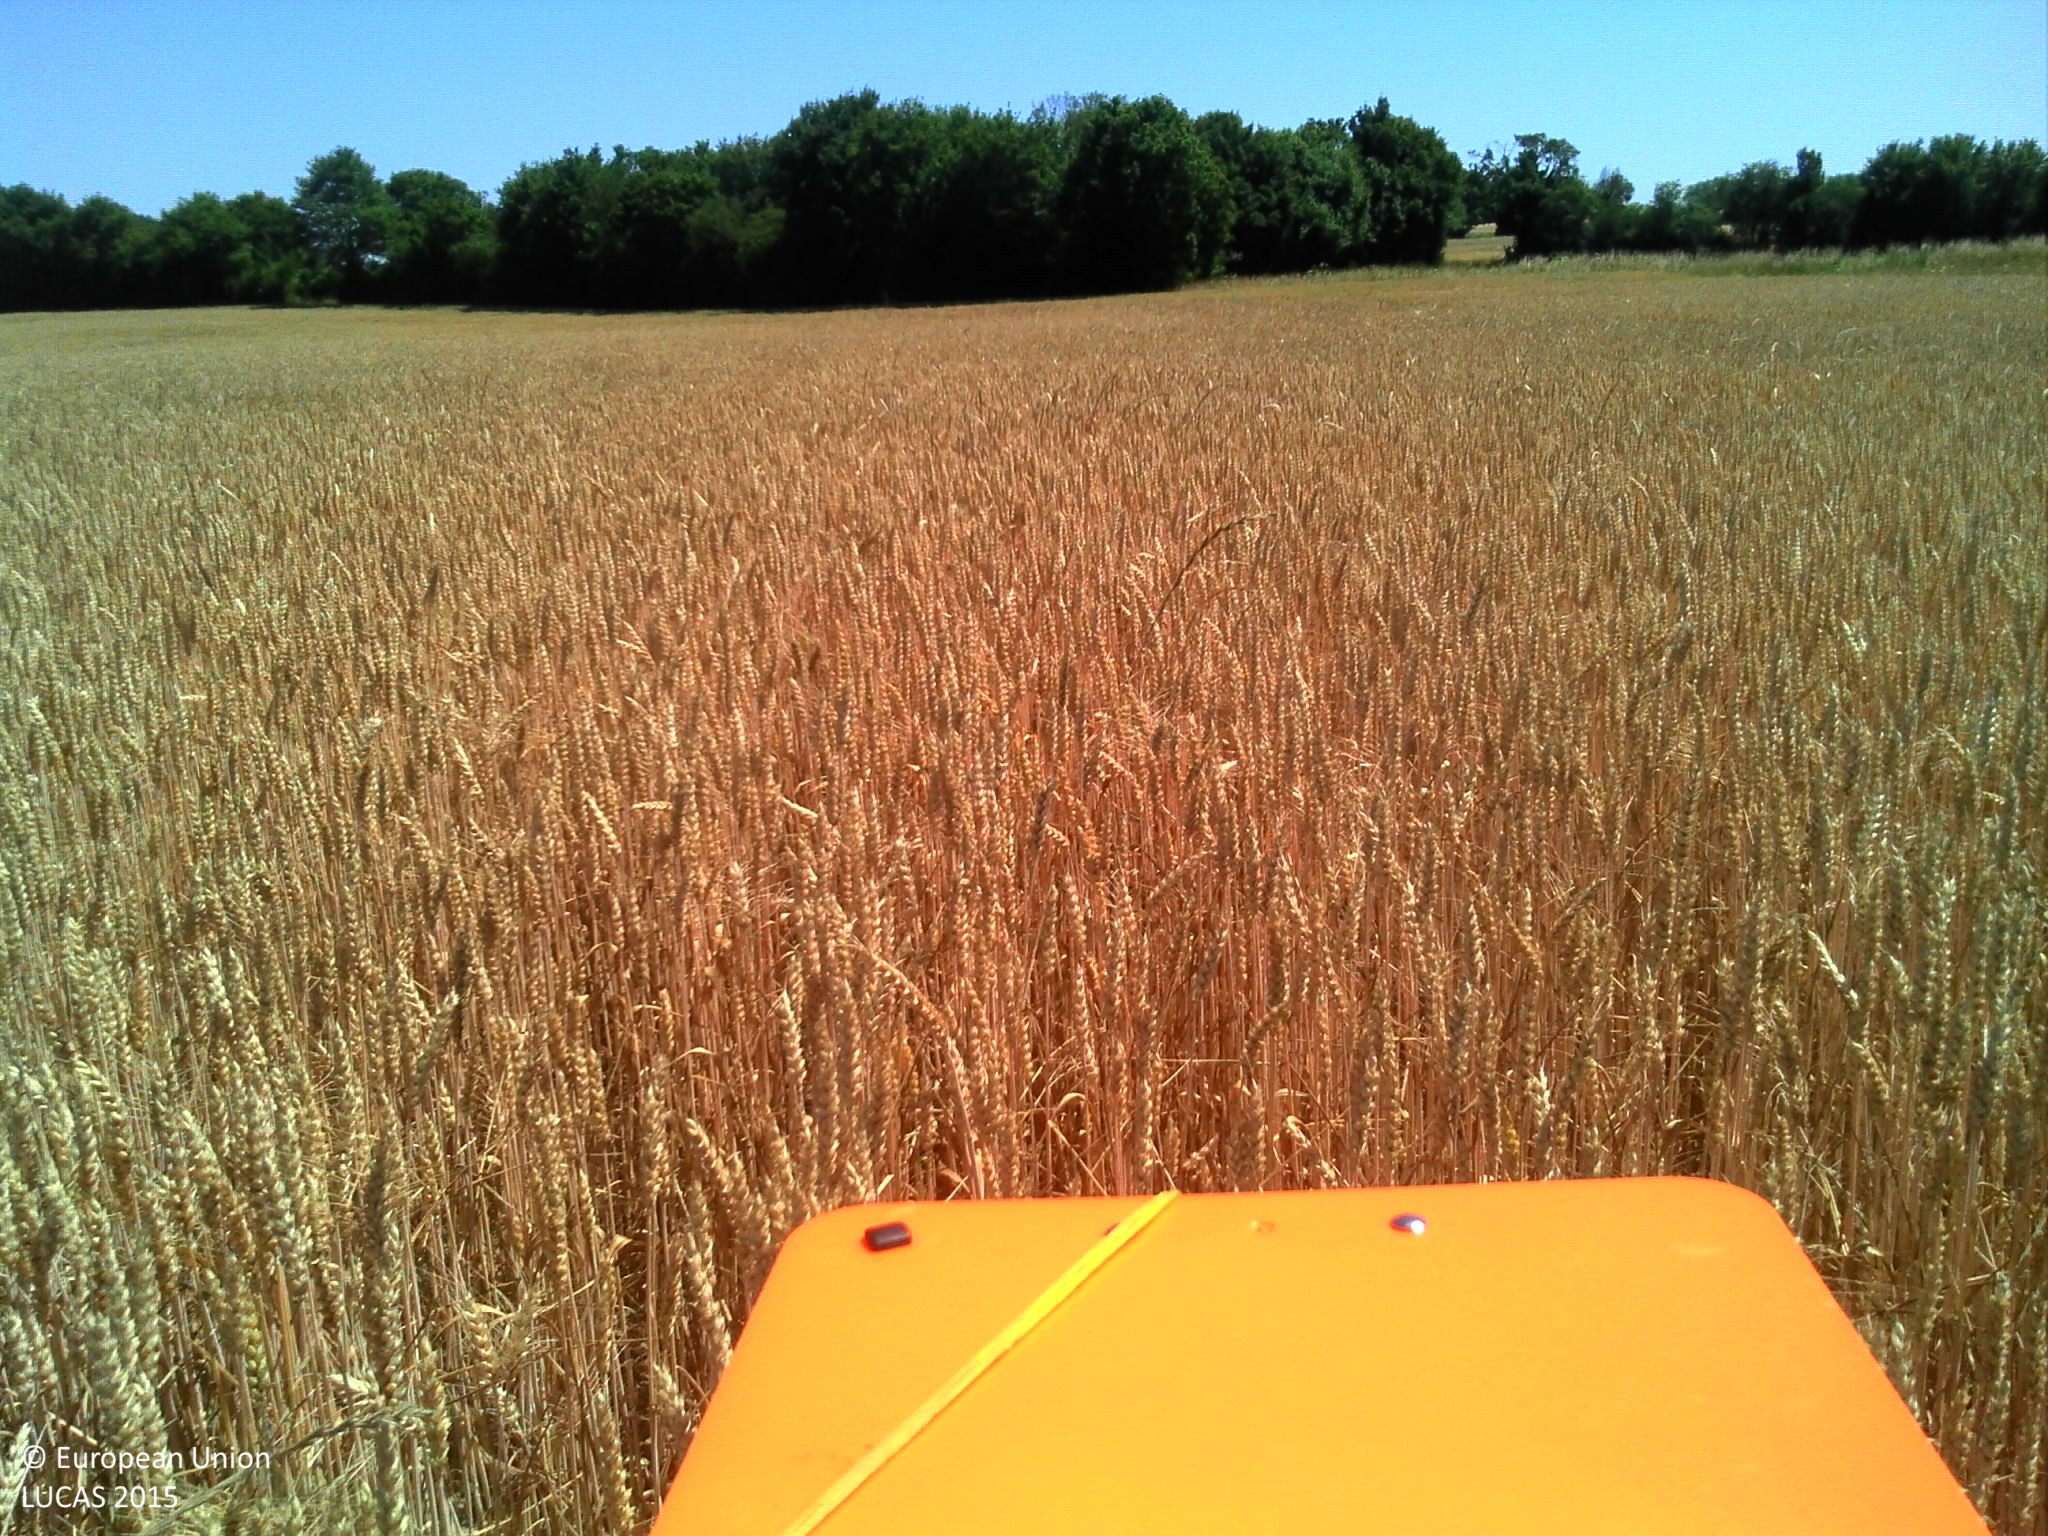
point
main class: Cropland
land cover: Common wheat
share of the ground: > 75 %
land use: Agriculture (excluding fallow land and kitchen gardens)
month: June
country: FR
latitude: 47.6136
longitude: 2.8758
